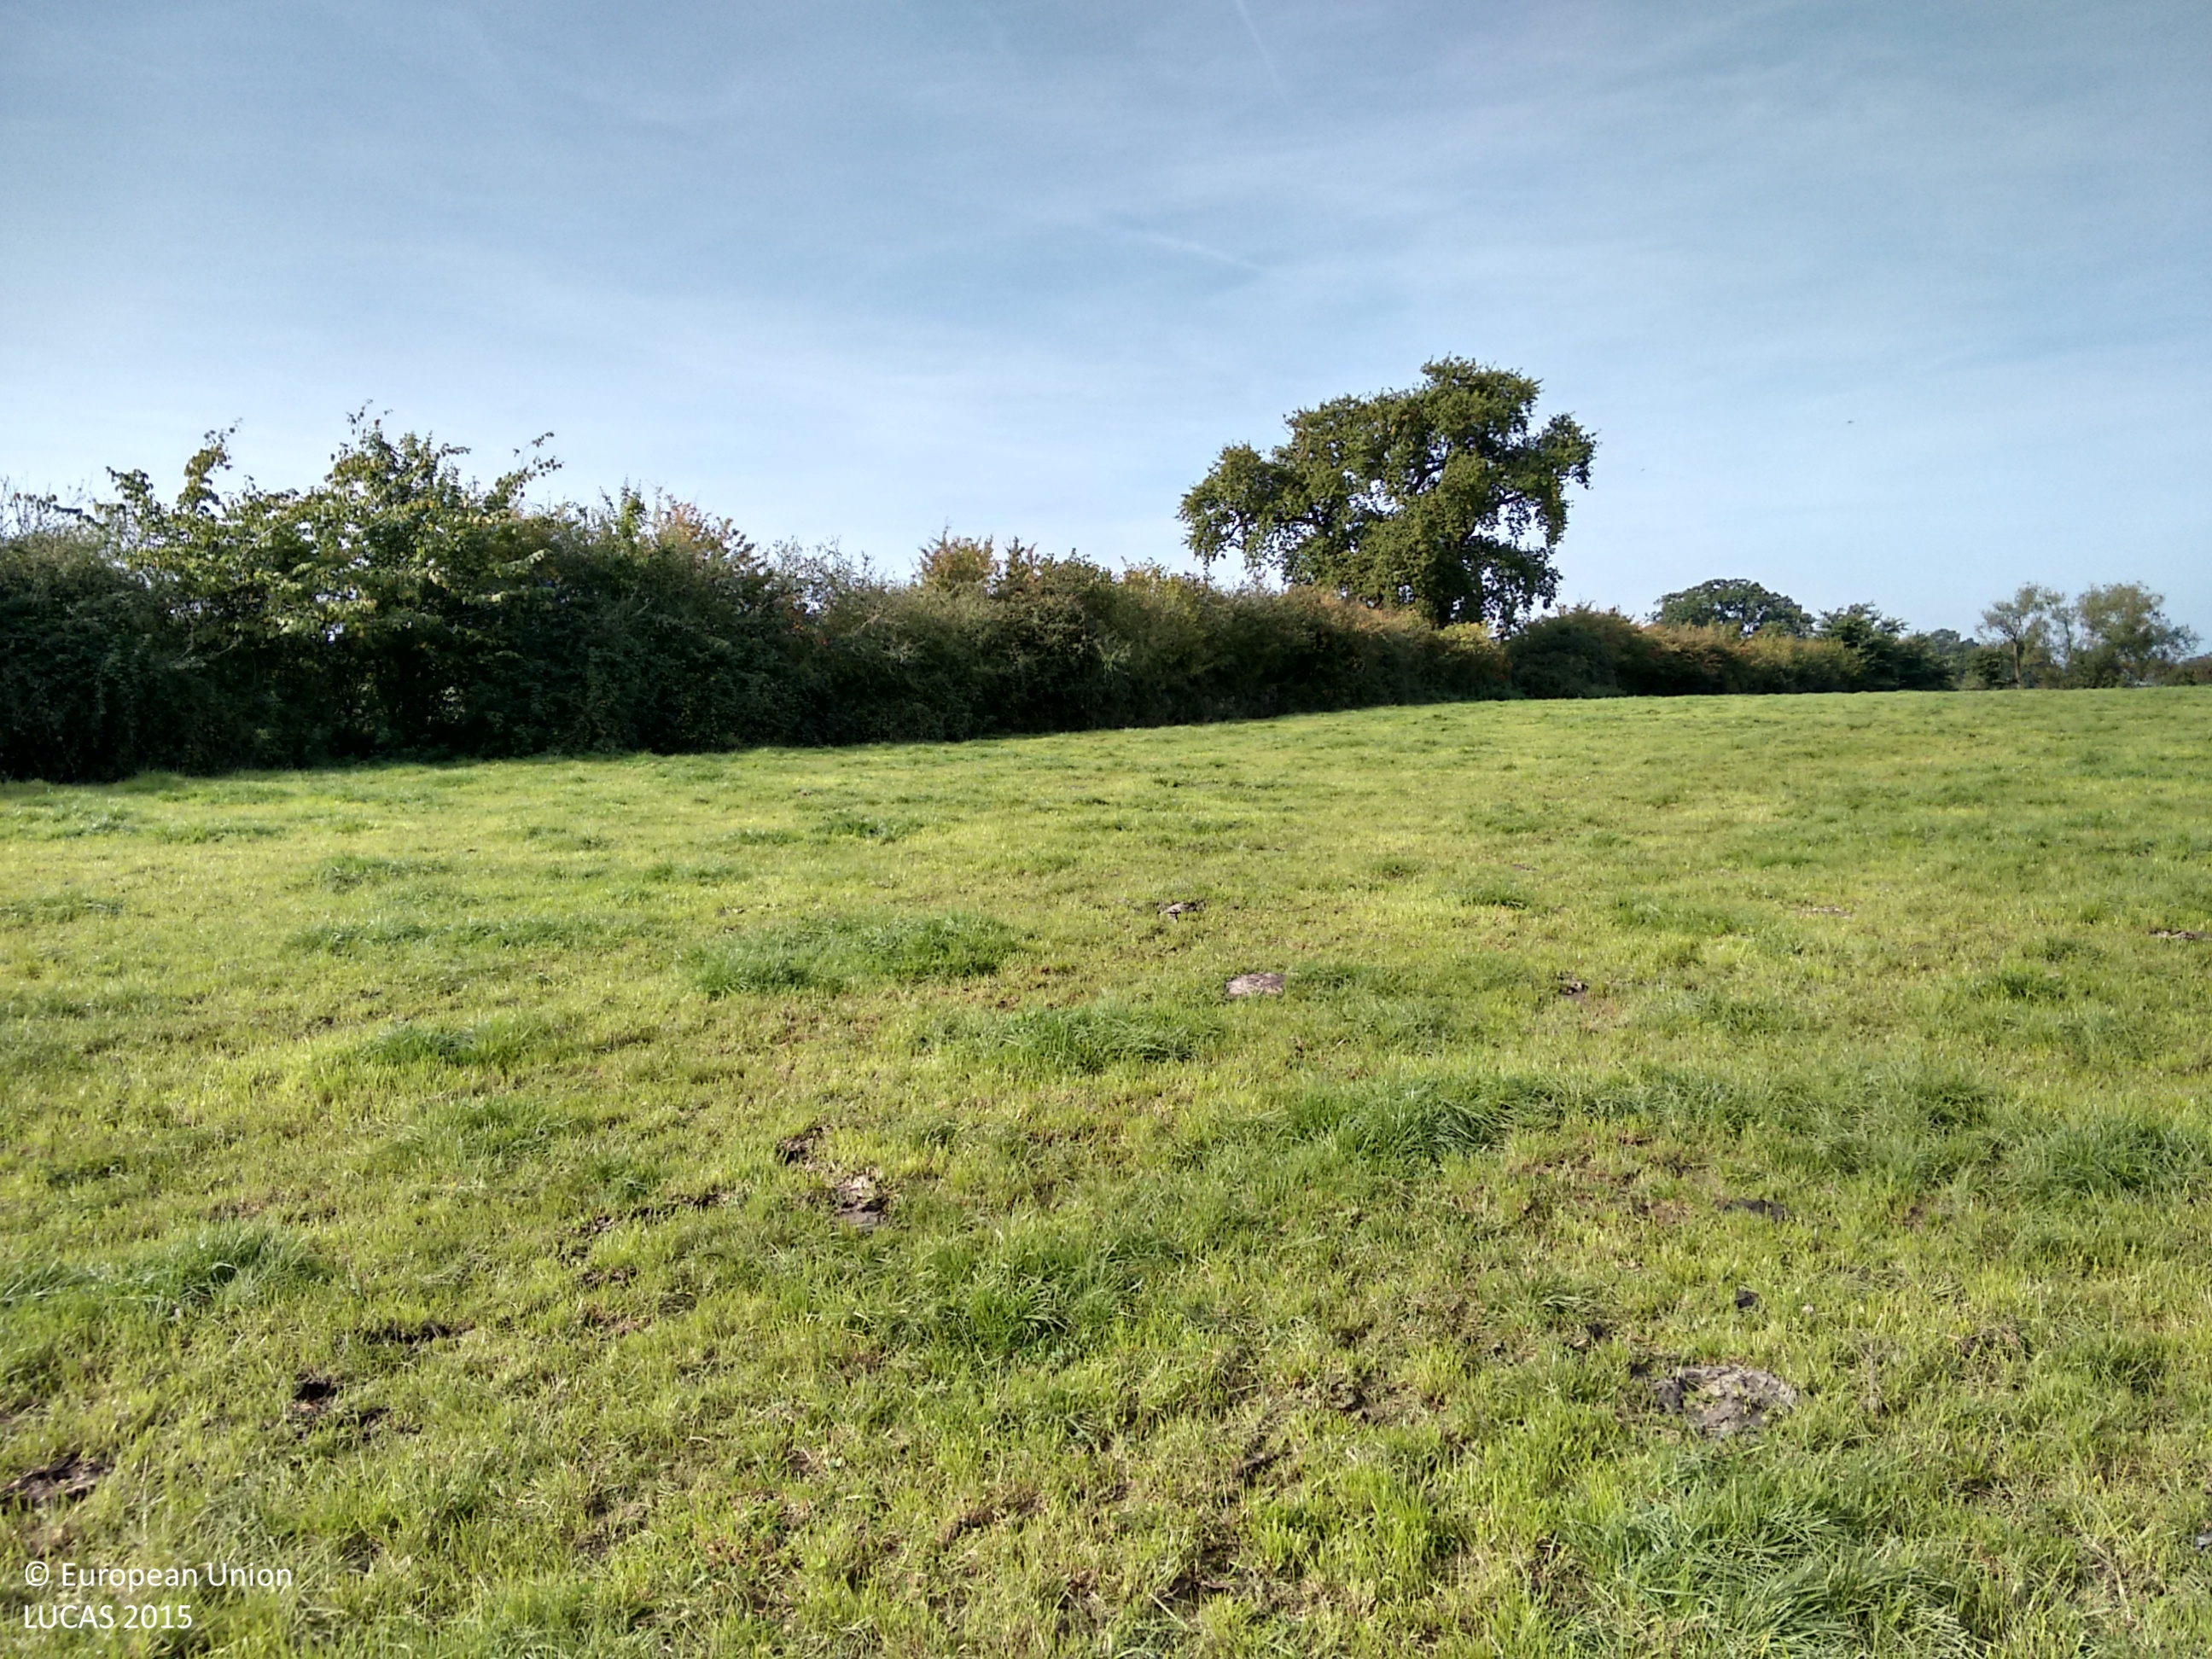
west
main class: Grassland
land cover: Grassland without tree/shrub cover
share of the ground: > 75 %
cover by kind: herbaceous plants 100 %
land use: Agriculture (excluding fallow land and kitchen gardens)
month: September
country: GB
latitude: 51.6313
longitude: -2.4174
